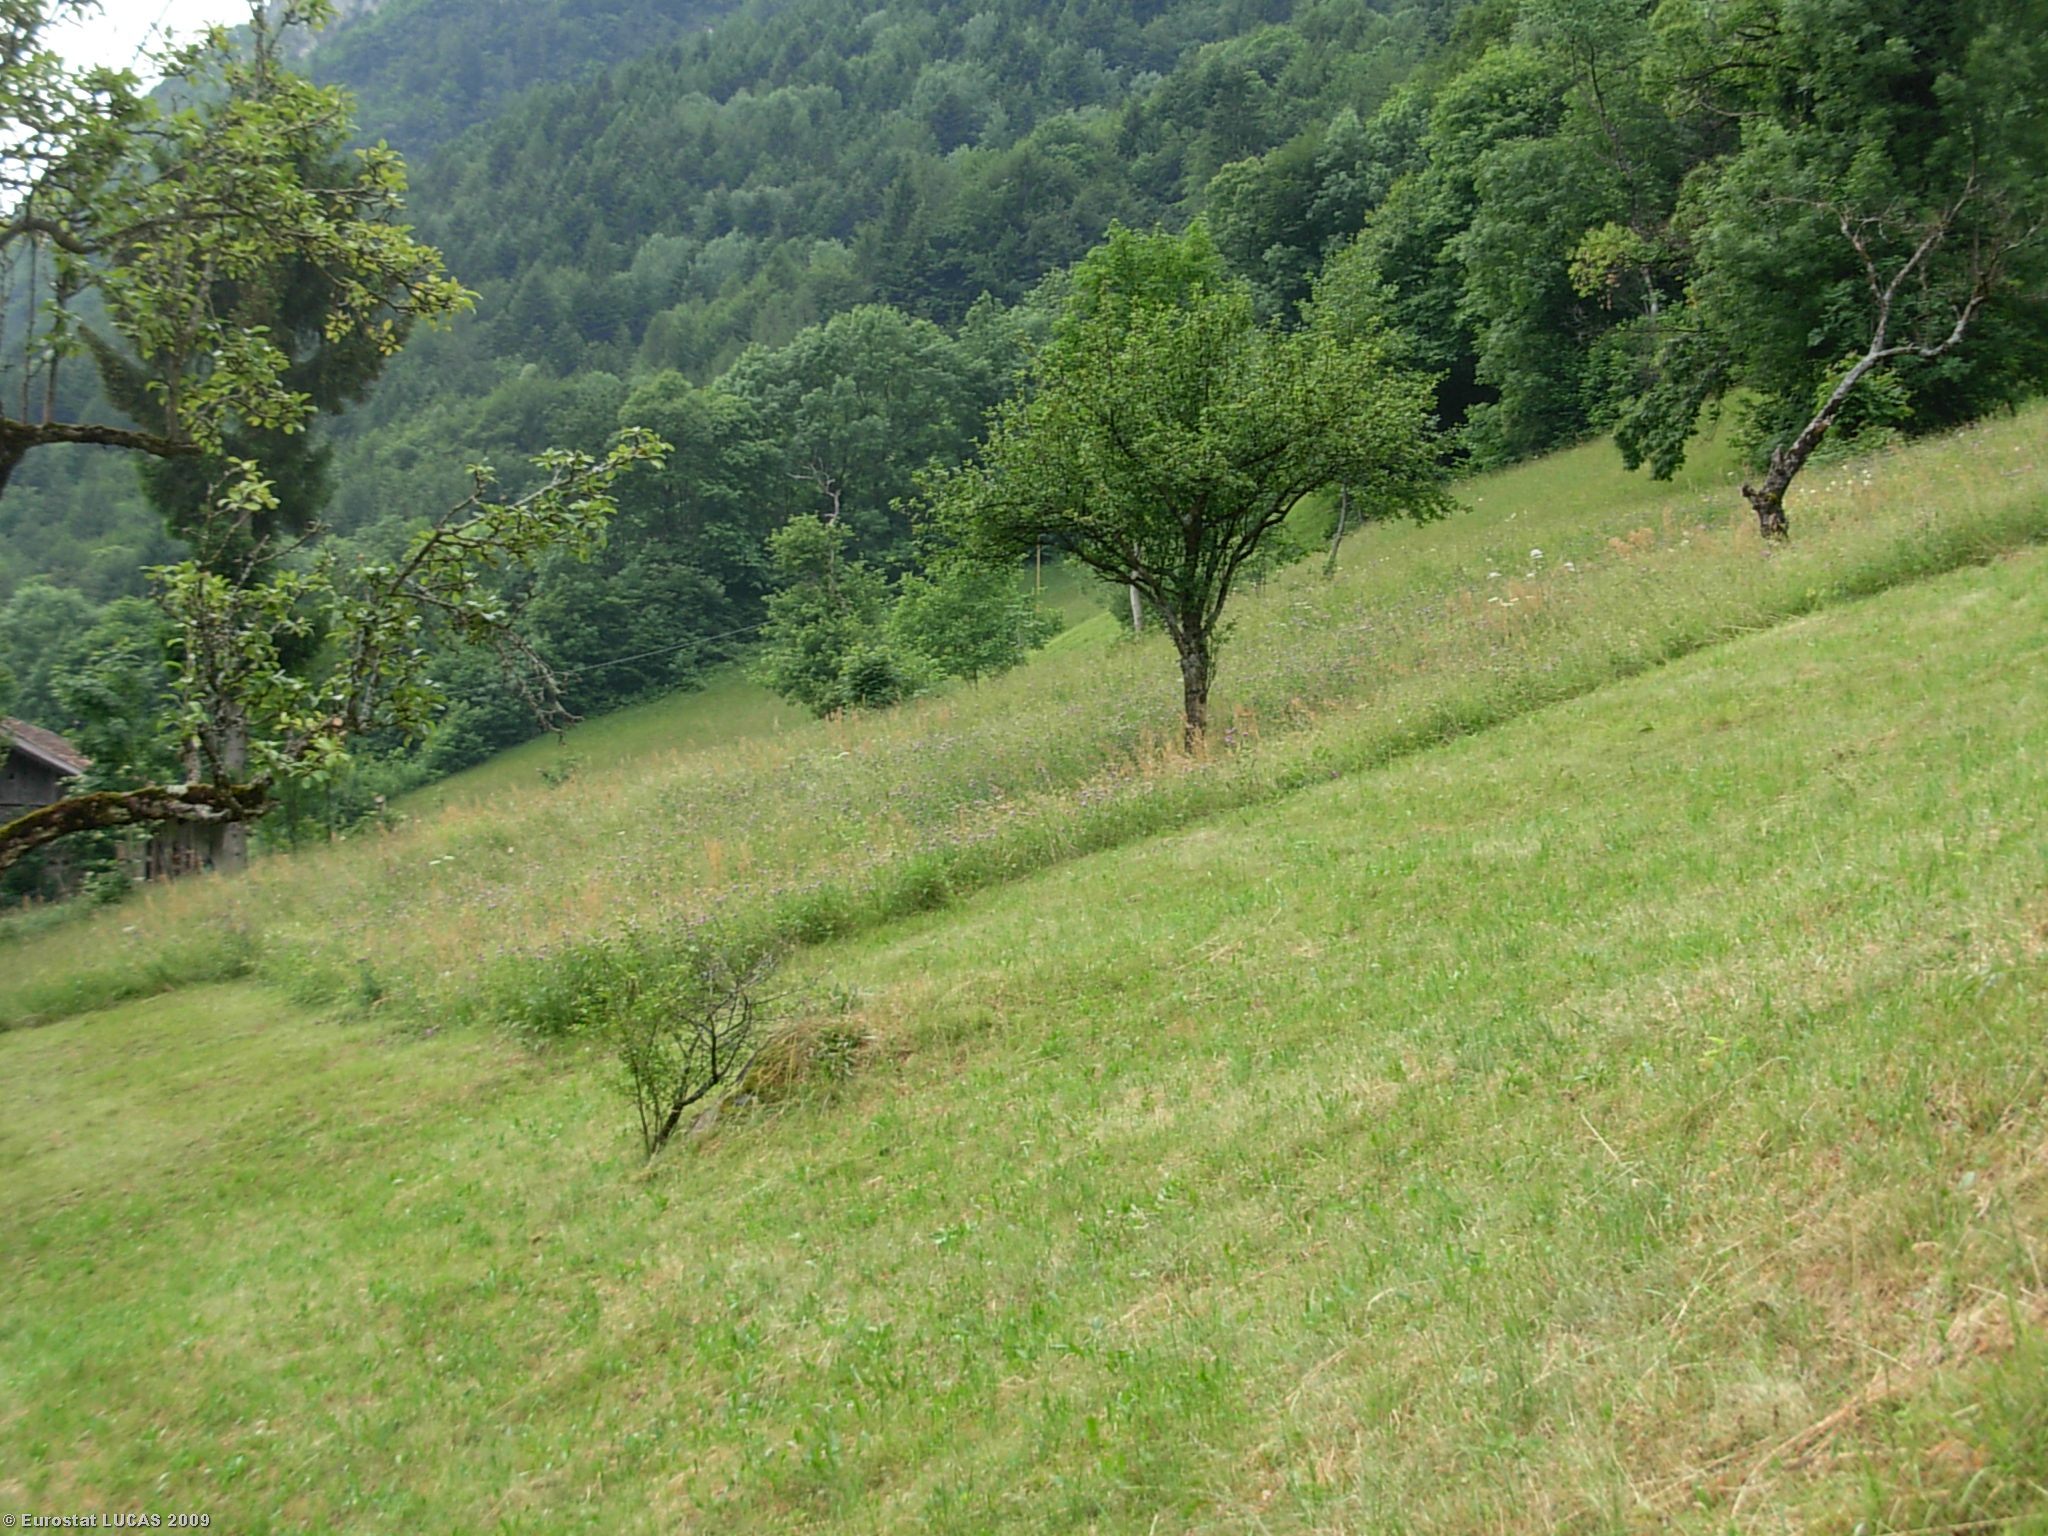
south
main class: Grassland
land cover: Grassland without tree/shrub cover
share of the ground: > 75 %
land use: Agriculture (excluding fallow land and kitchen gardens)
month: June
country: IT
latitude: 45.8278
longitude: 10.4498
